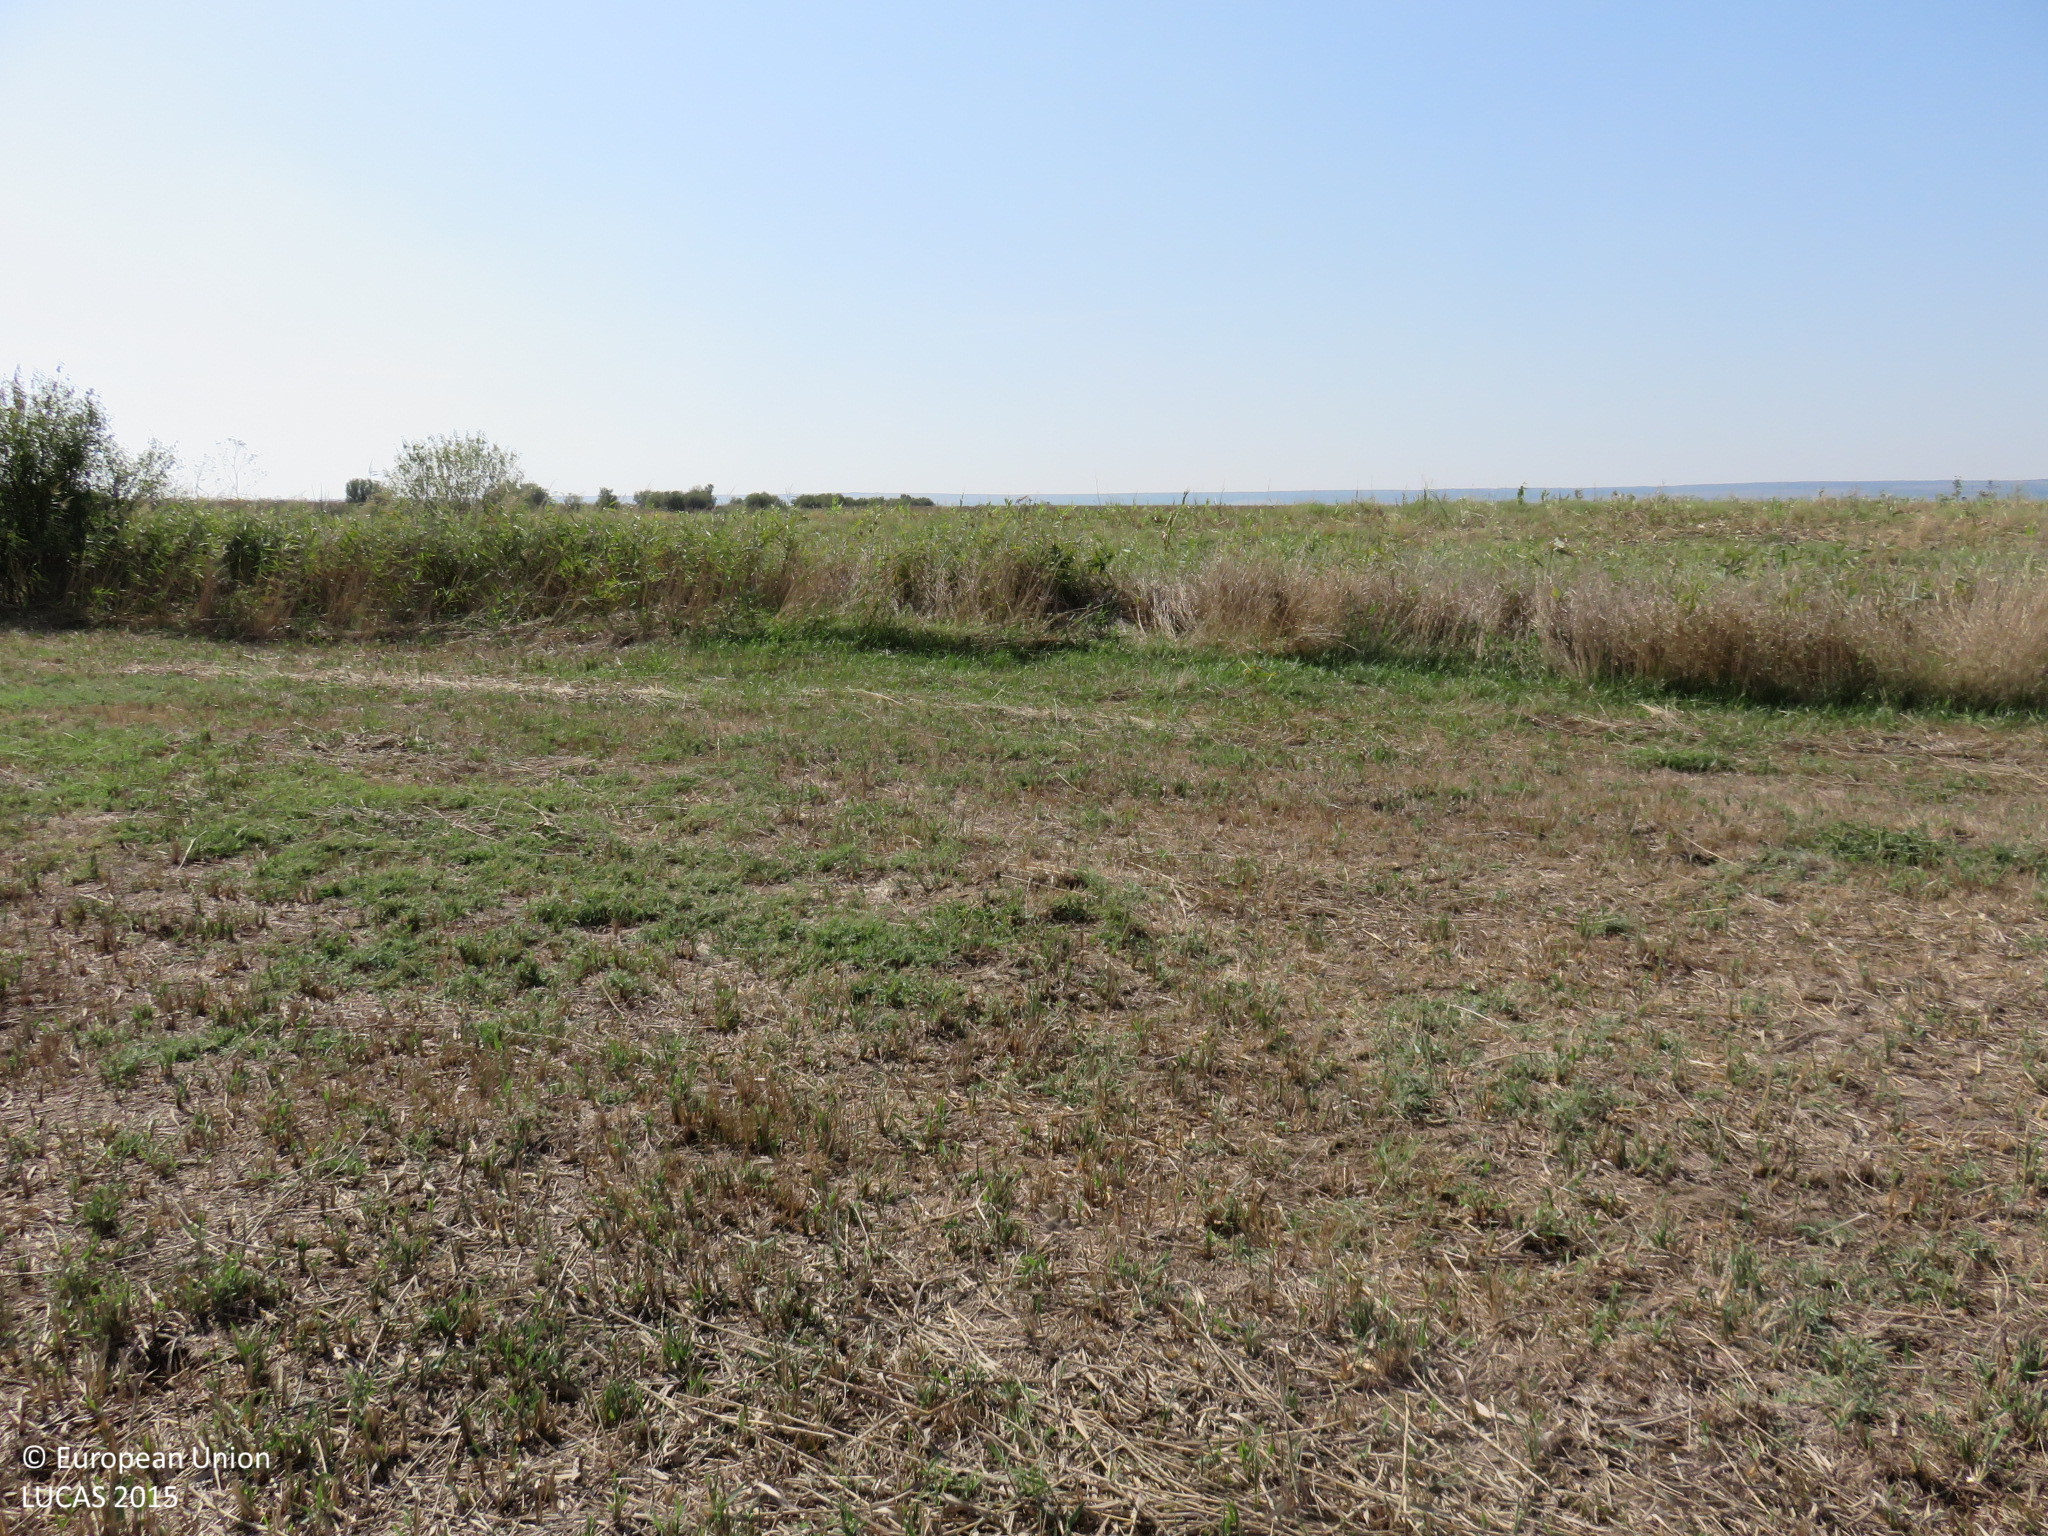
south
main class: Grassland
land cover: Grassland without tree/shrub cover
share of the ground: > 75 %
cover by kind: herbaceous plants 100 %
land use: Agriculture (excluding fallow land and kitchen gardens)
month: September
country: BG
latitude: 43.7177
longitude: 24.5750
